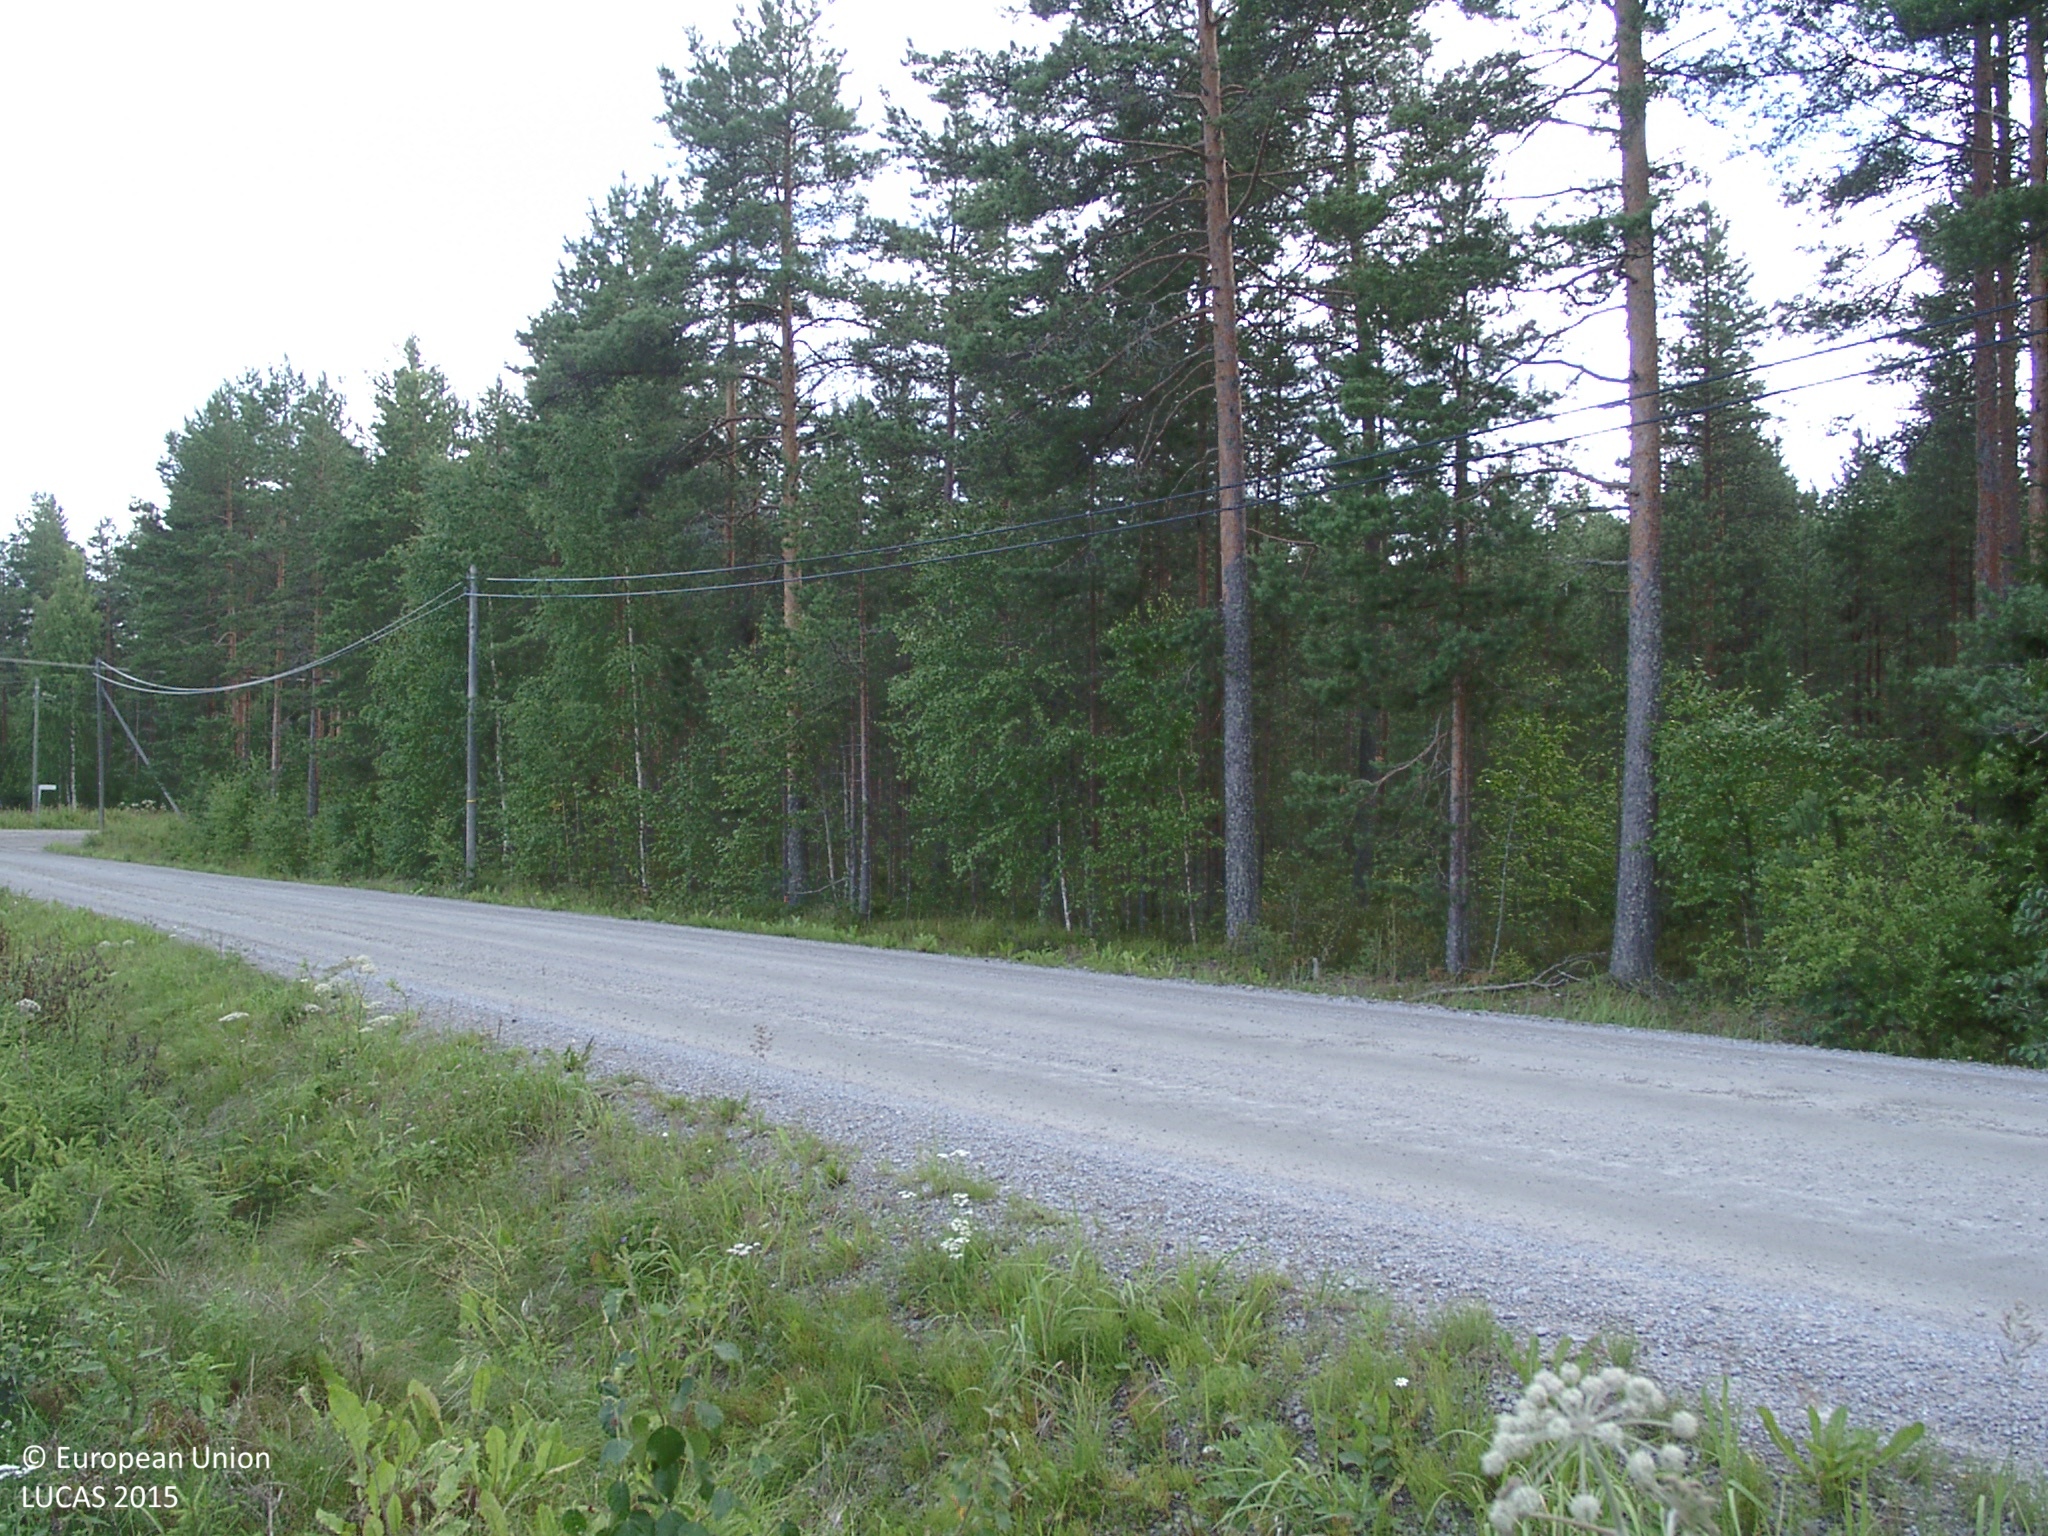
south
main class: Cropland
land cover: Oats
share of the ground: > 75 %
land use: Agriculture (excluding fallow land and kitchen gardens)
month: July
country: FI
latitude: 62.3657
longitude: 25.7538
